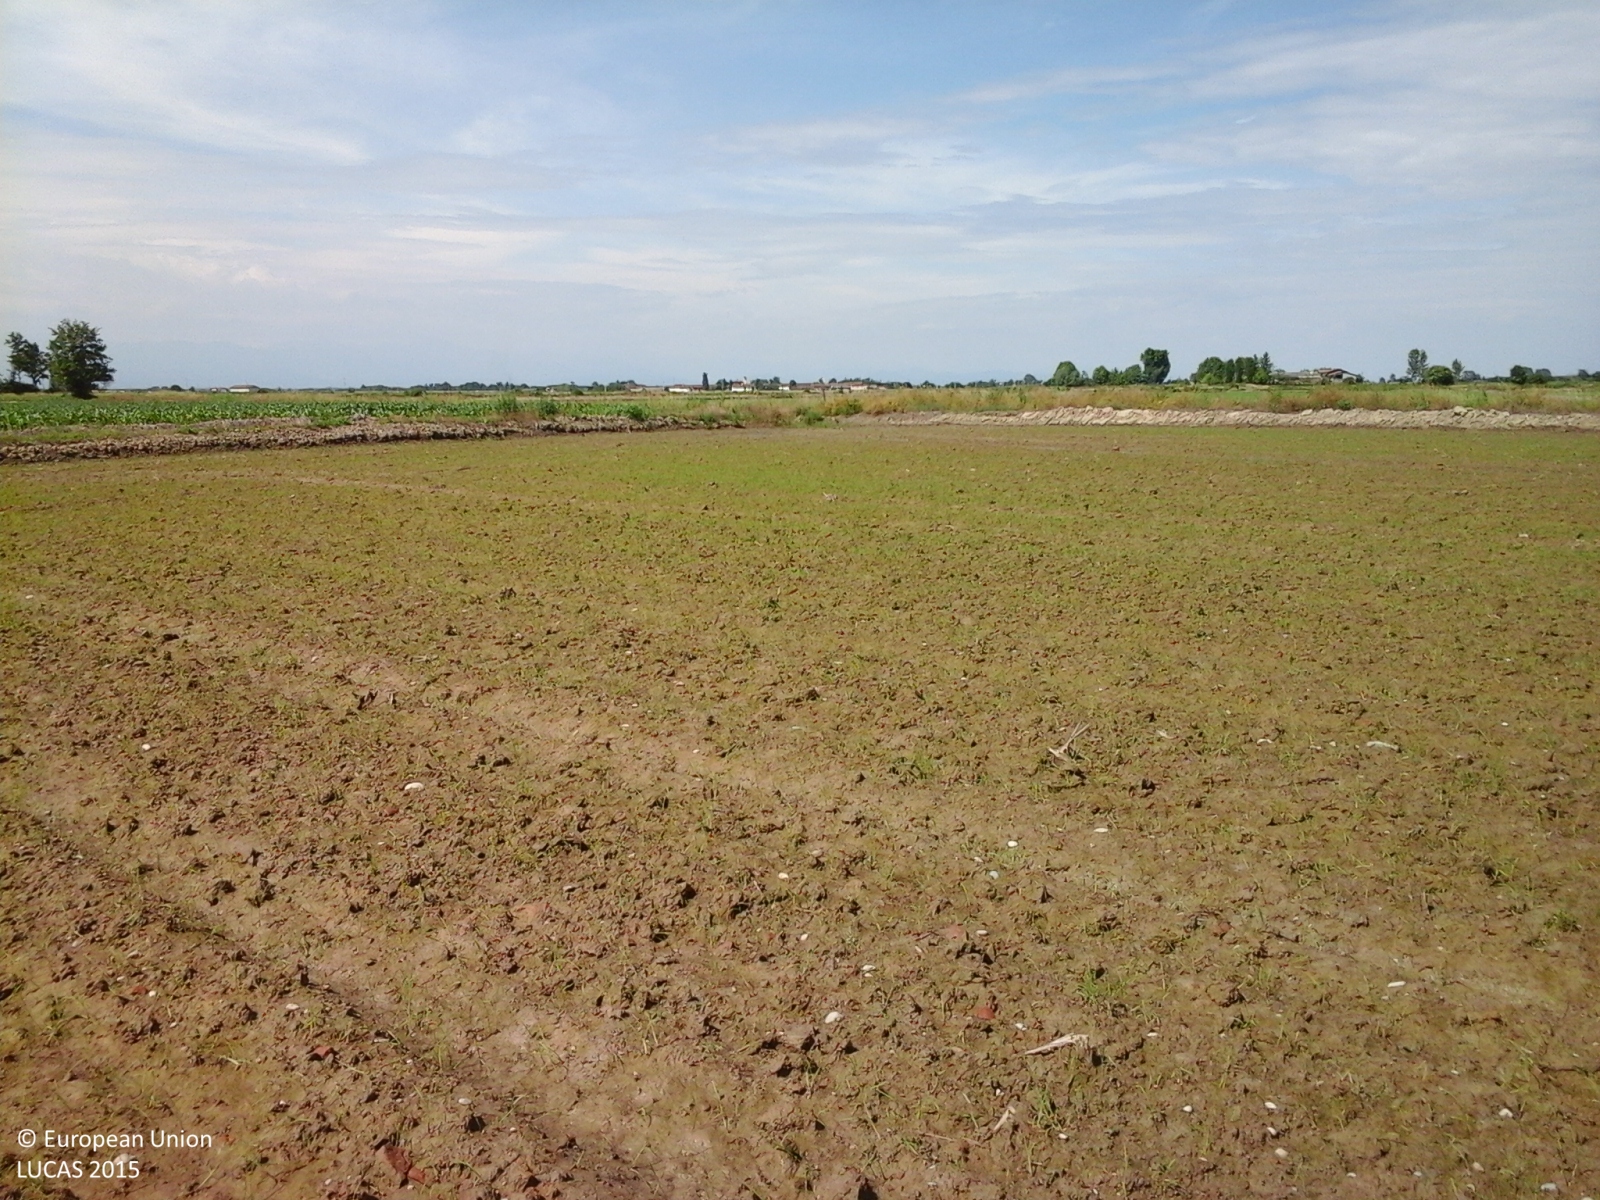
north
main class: Cropland
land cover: Rice
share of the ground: < 10 %
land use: Agriculture (excluding fallow land and kitchen gardens)
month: May
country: IT
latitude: 45.3093
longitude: 8.2301
